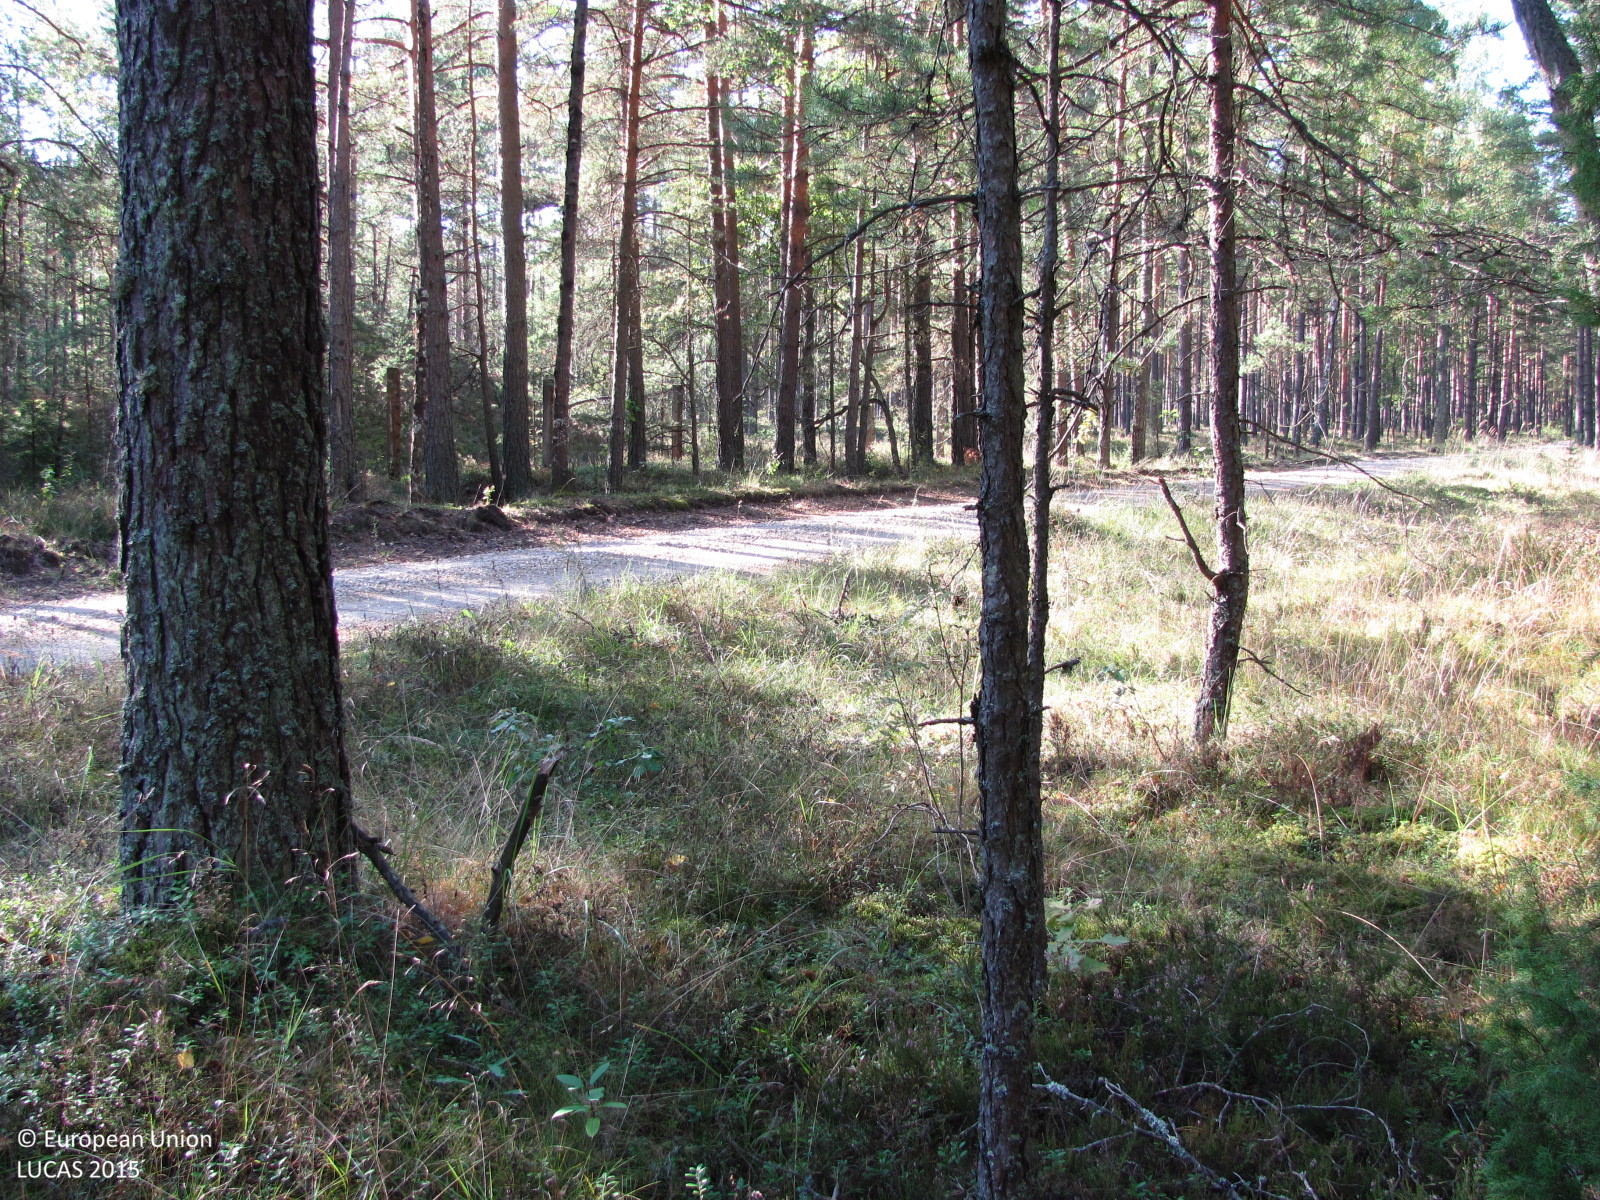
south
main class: Woodland
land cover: Pine dominated coniferous woodland
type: hemiboreal forest and nemoral coniferous forest and mixed broadleaved-coniferous forest
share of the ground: > 75 %
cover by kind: coniferous forest trees 80 %, herbaceous plants 10 %, lichens and mosses 10 %
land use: Forestry
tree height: > 5 m
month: September
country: LV
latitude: 57.1082
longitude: 24.2369
